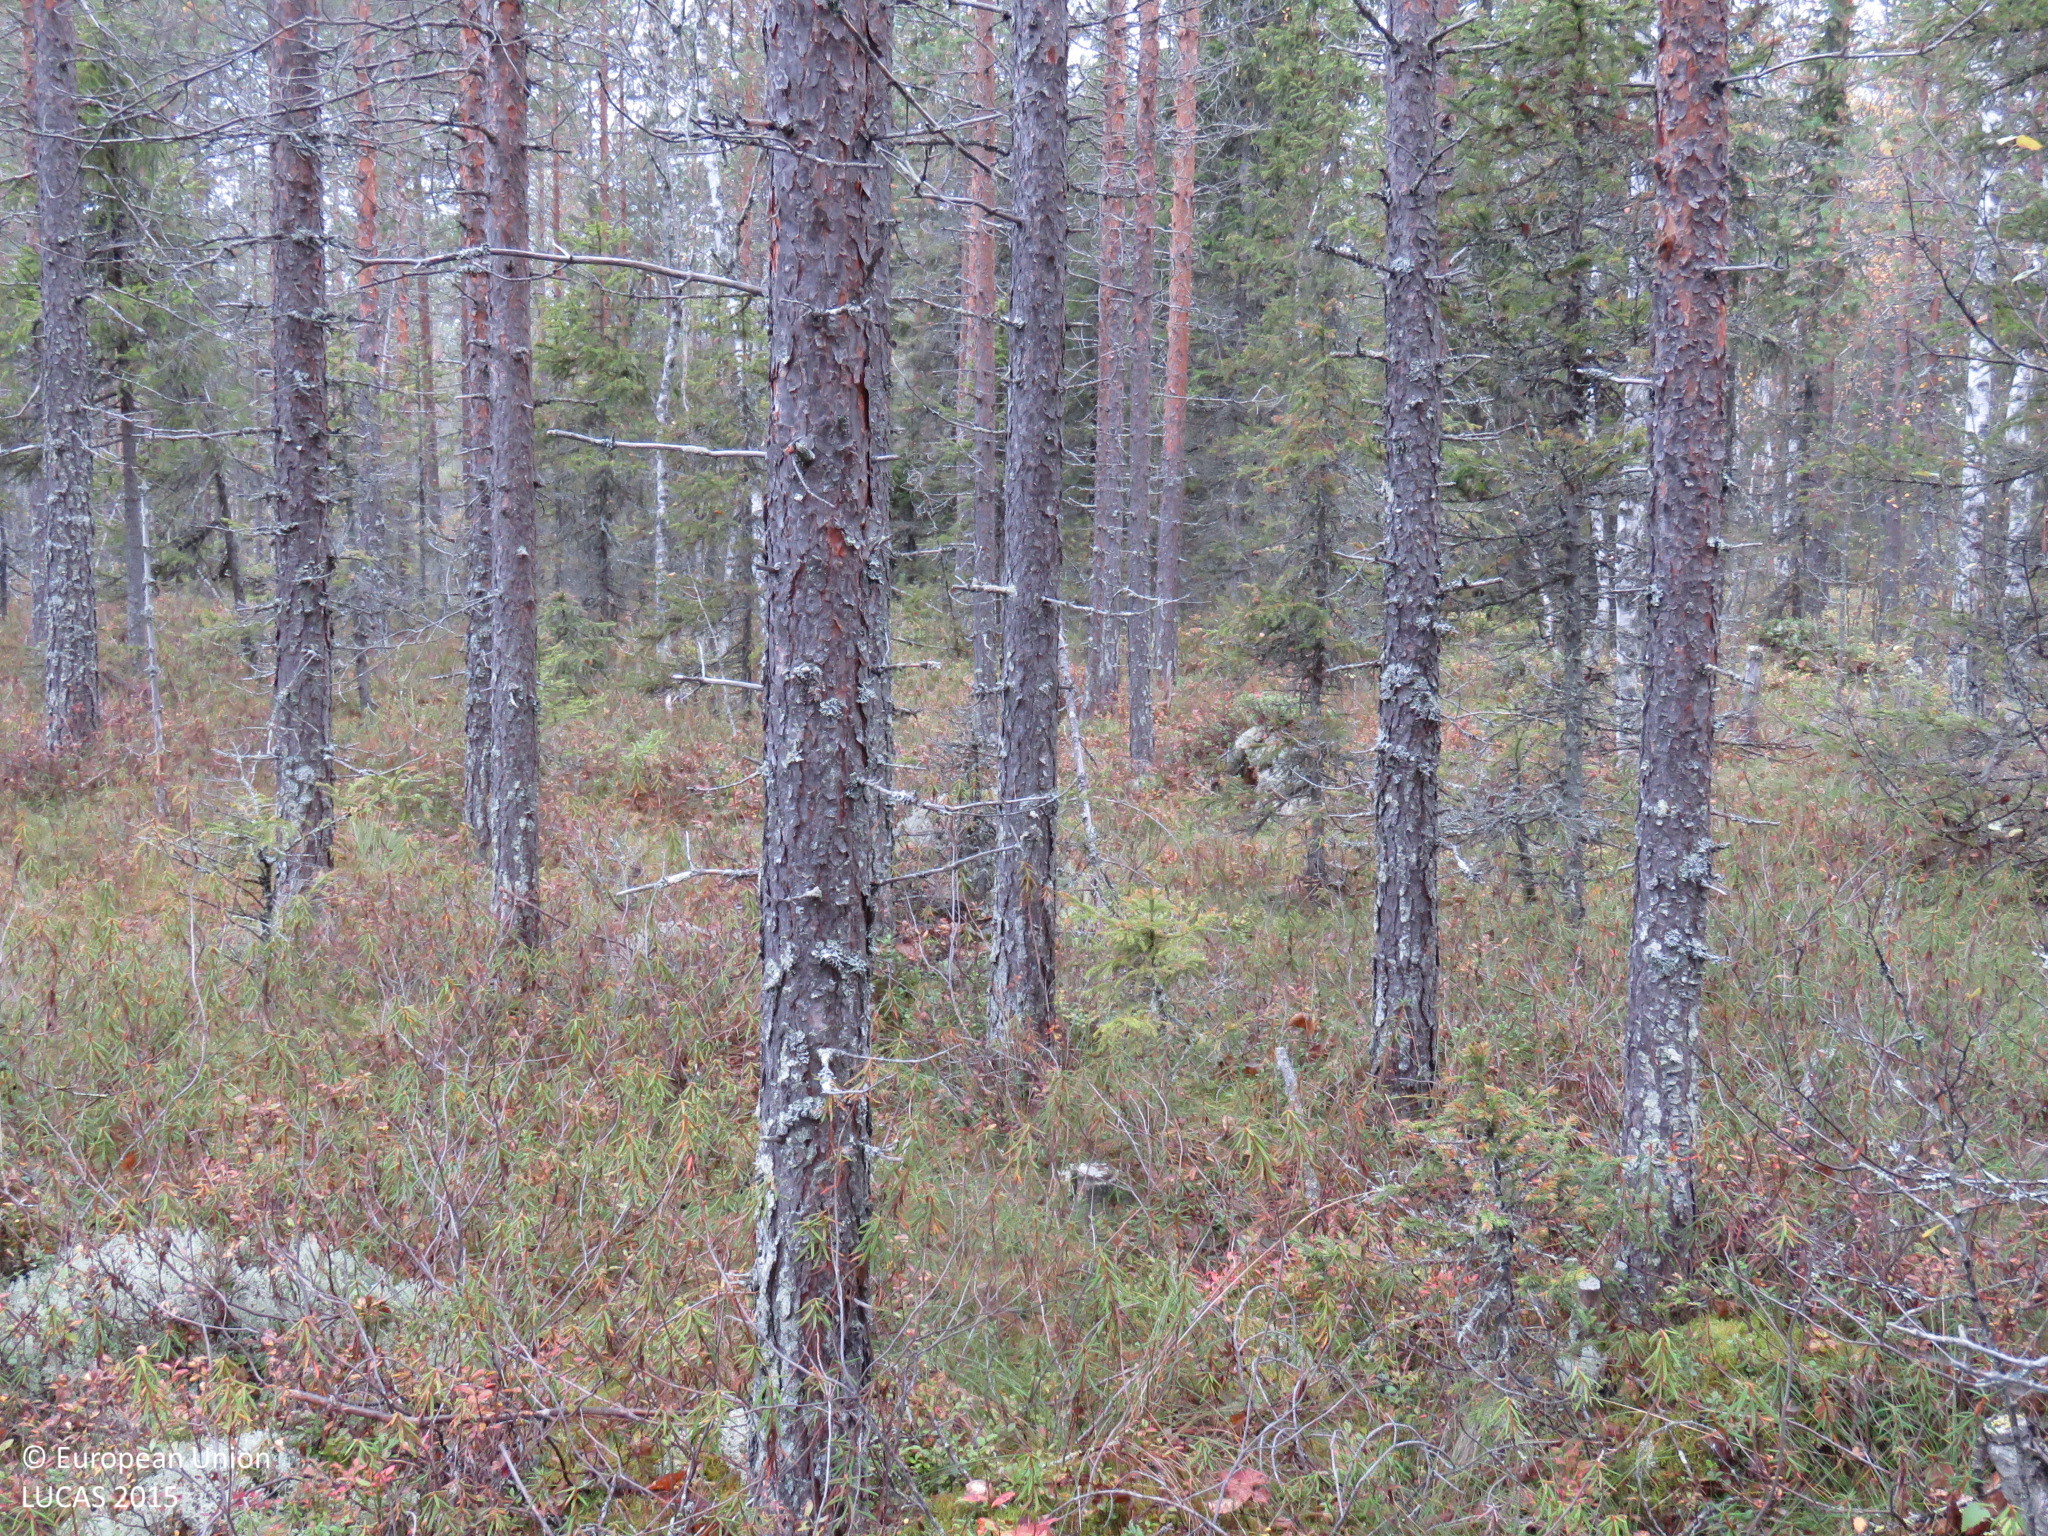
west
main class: Woodland
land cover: Other mixed woodland
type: mire and swamp forests
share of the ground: > 75 %
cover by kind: coniferous forest trees 50 %, broadleaved forest trees 25 %, shrubs 10 %, lichens and mosses 10 %, herbaceous plants 5 %
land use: Forestry
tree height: > 5 m
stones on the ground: < 10 %
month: September
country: FI
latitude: 64.8395
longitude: 27.0529
